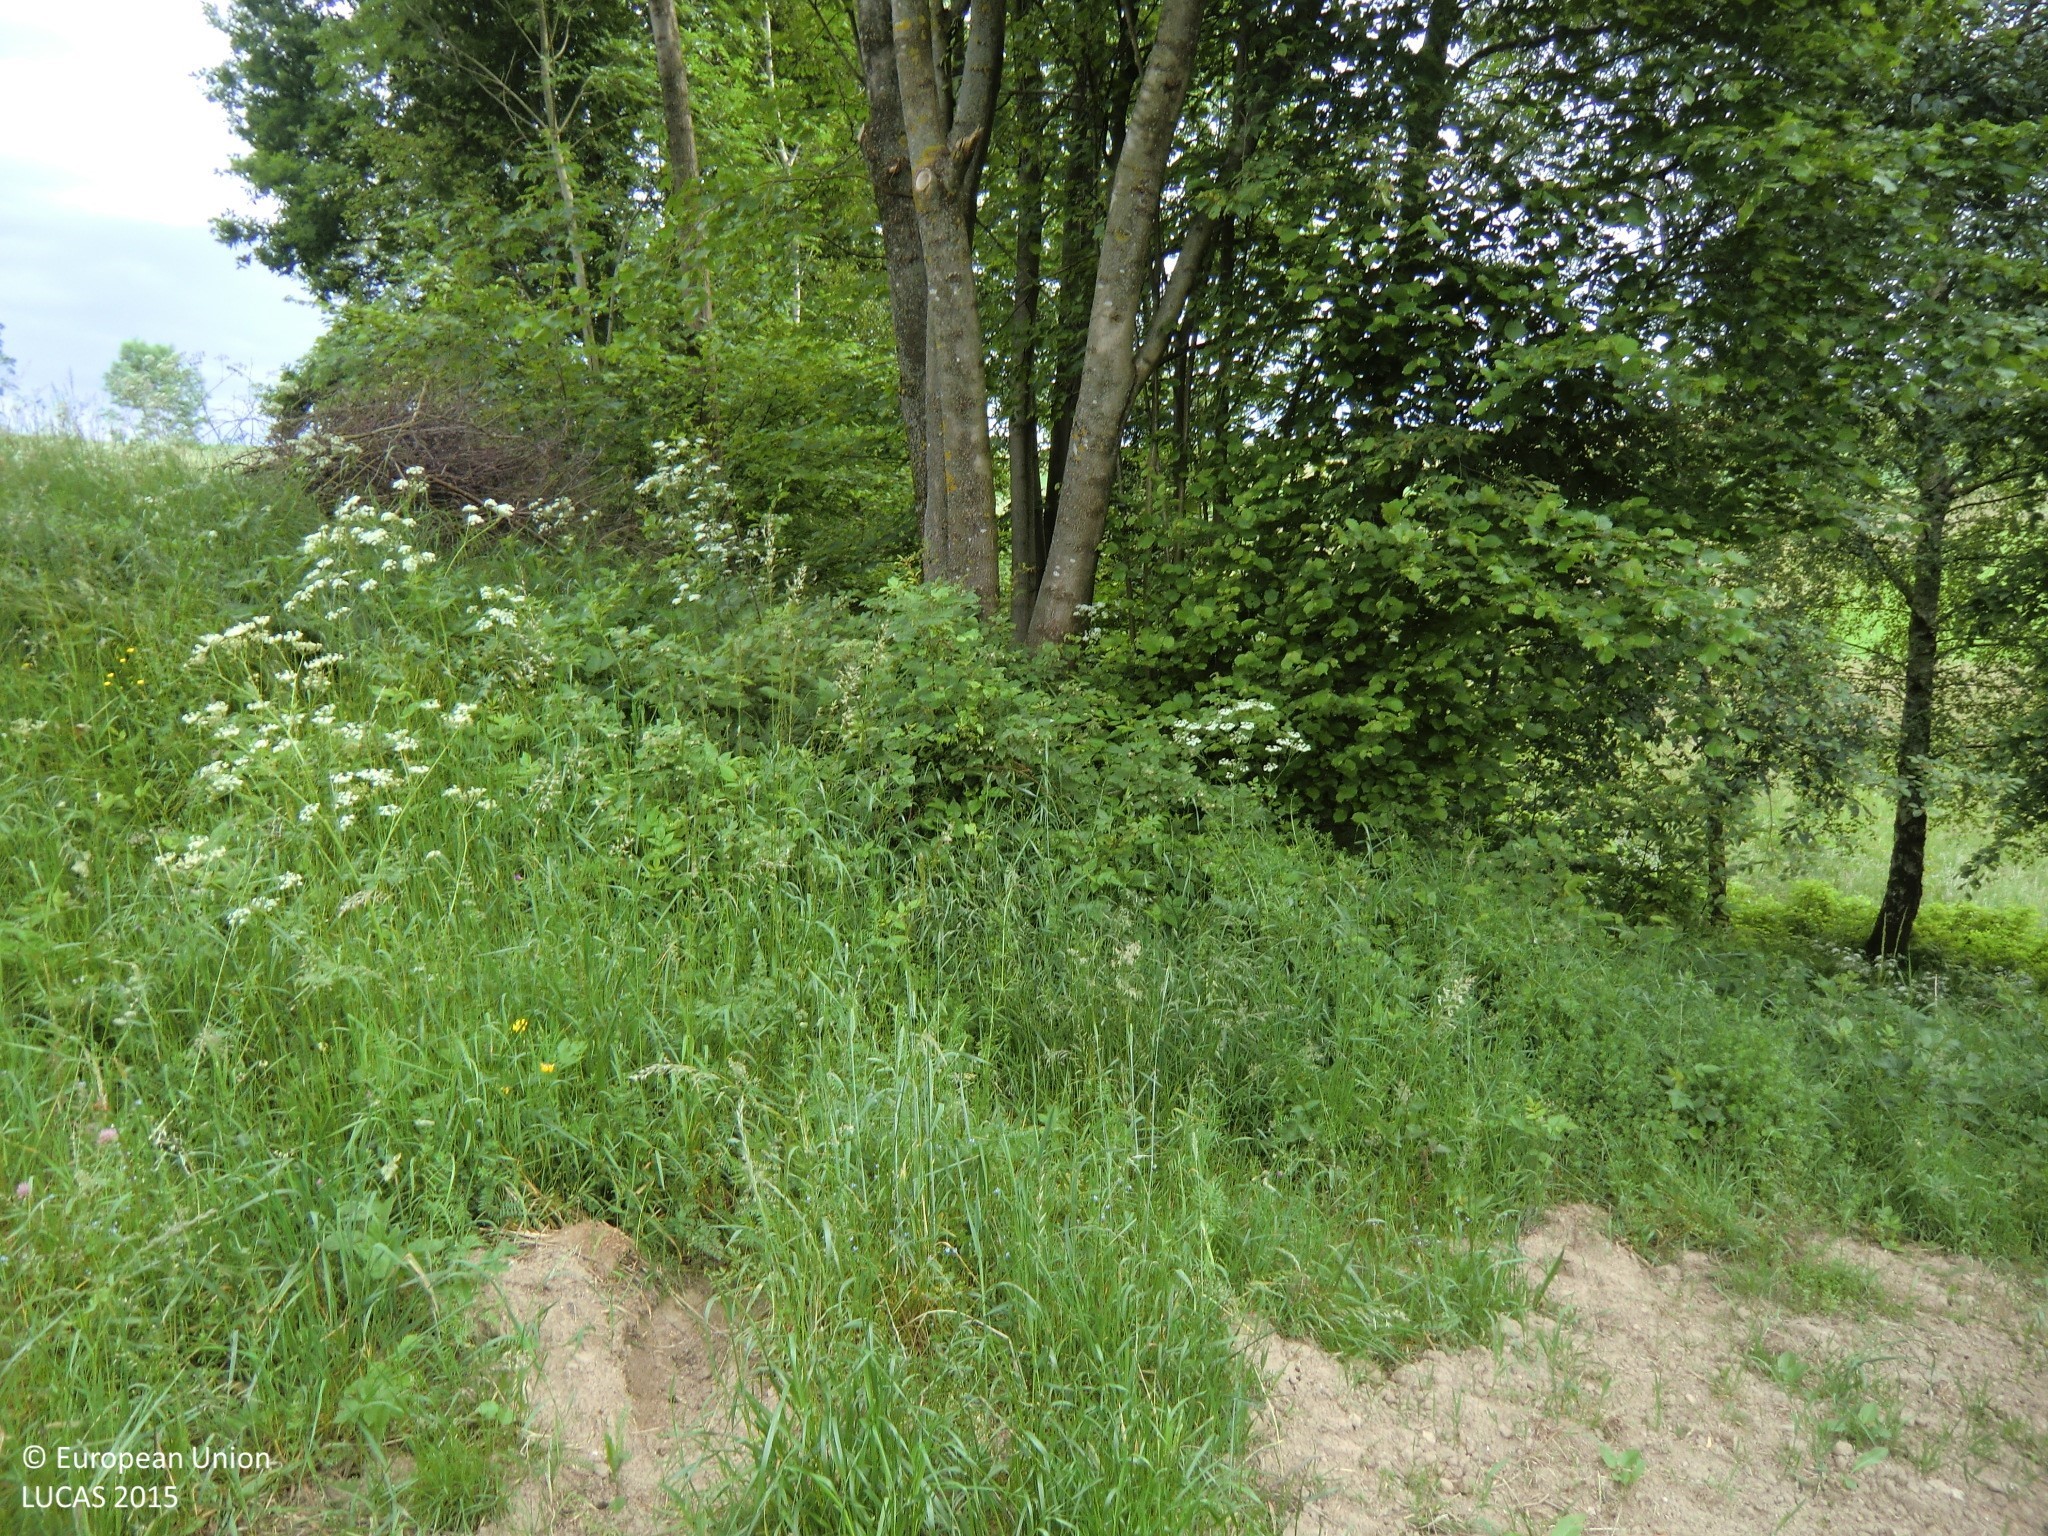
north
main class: Cropland
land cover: Maize
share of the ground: 10 - 25 %
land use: Agriculture (excluding fallow land and kitchen gardens)
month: June
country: AT
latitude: 48.2532
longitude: 15.0251
